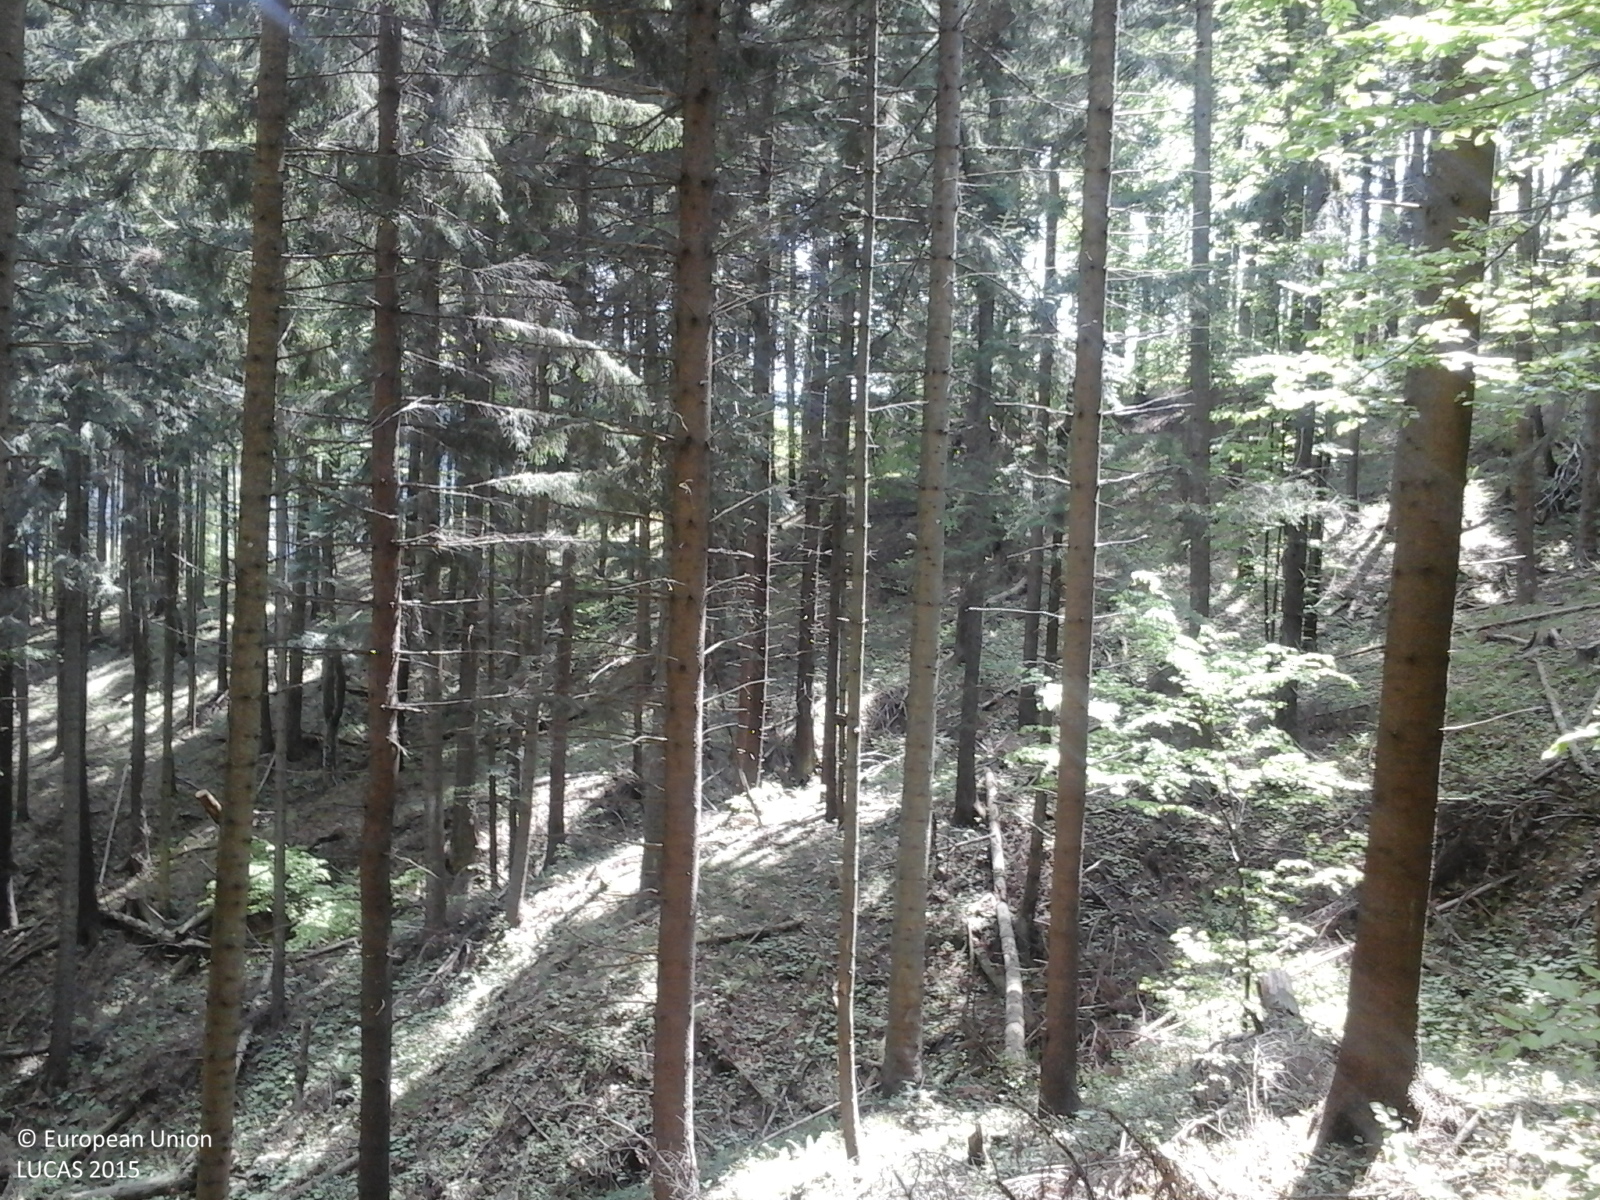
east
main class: Woodland
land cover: Spruce dominated mixed woodland
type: alpine coniferous forest
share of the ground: > 75 %
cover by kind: coniferous forest trees 75 %, broadleaved forest trees 25 %
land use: Forestry
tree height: > 5 m
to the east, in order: Spruce dominated mixed woodland; Tracks; Spruce dominated mixed woodland
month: May
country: RO
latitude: 45.9857
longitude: 26.3262
